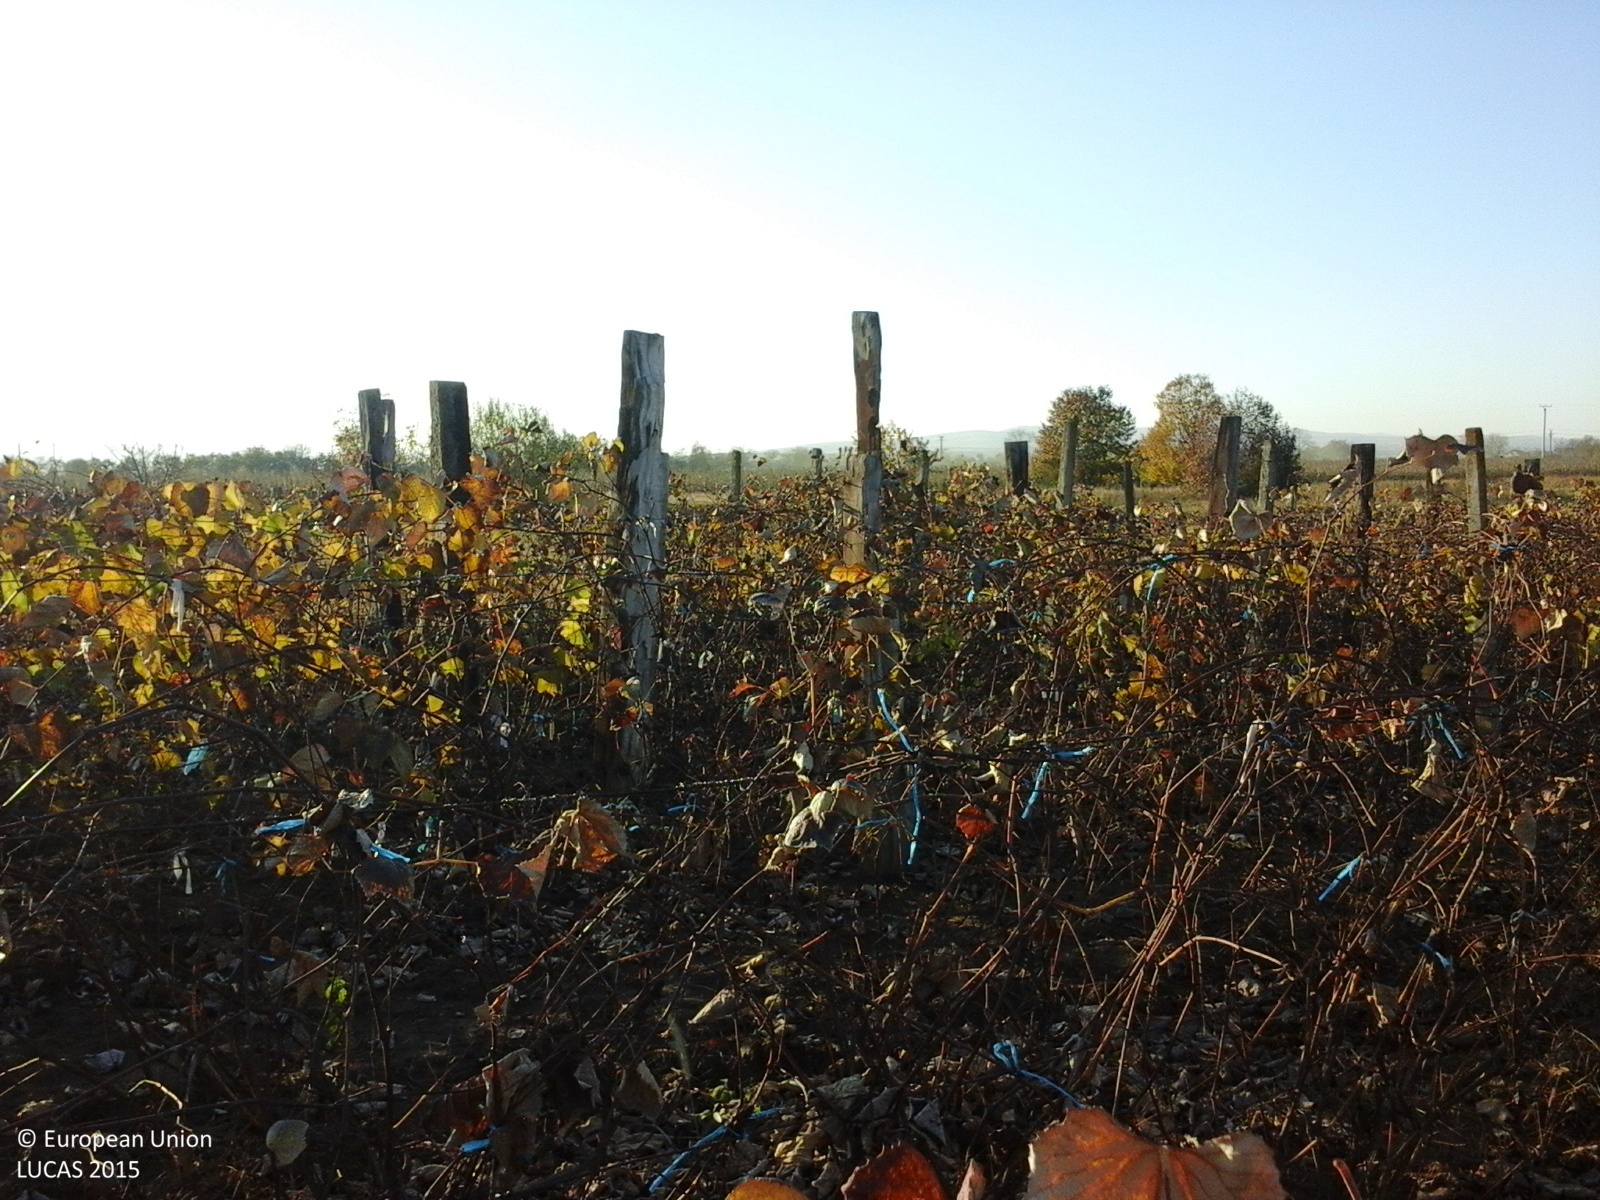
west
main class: Cropland
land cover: Vineyards
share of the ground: 50 - 75 %
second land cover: Other bare soil
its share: > 75 %
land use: Agriculture (excluding fallow land and kitchen gardens)
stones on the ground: < 10 %
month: October
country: RO
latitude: 46.1230
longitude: 27.1938
